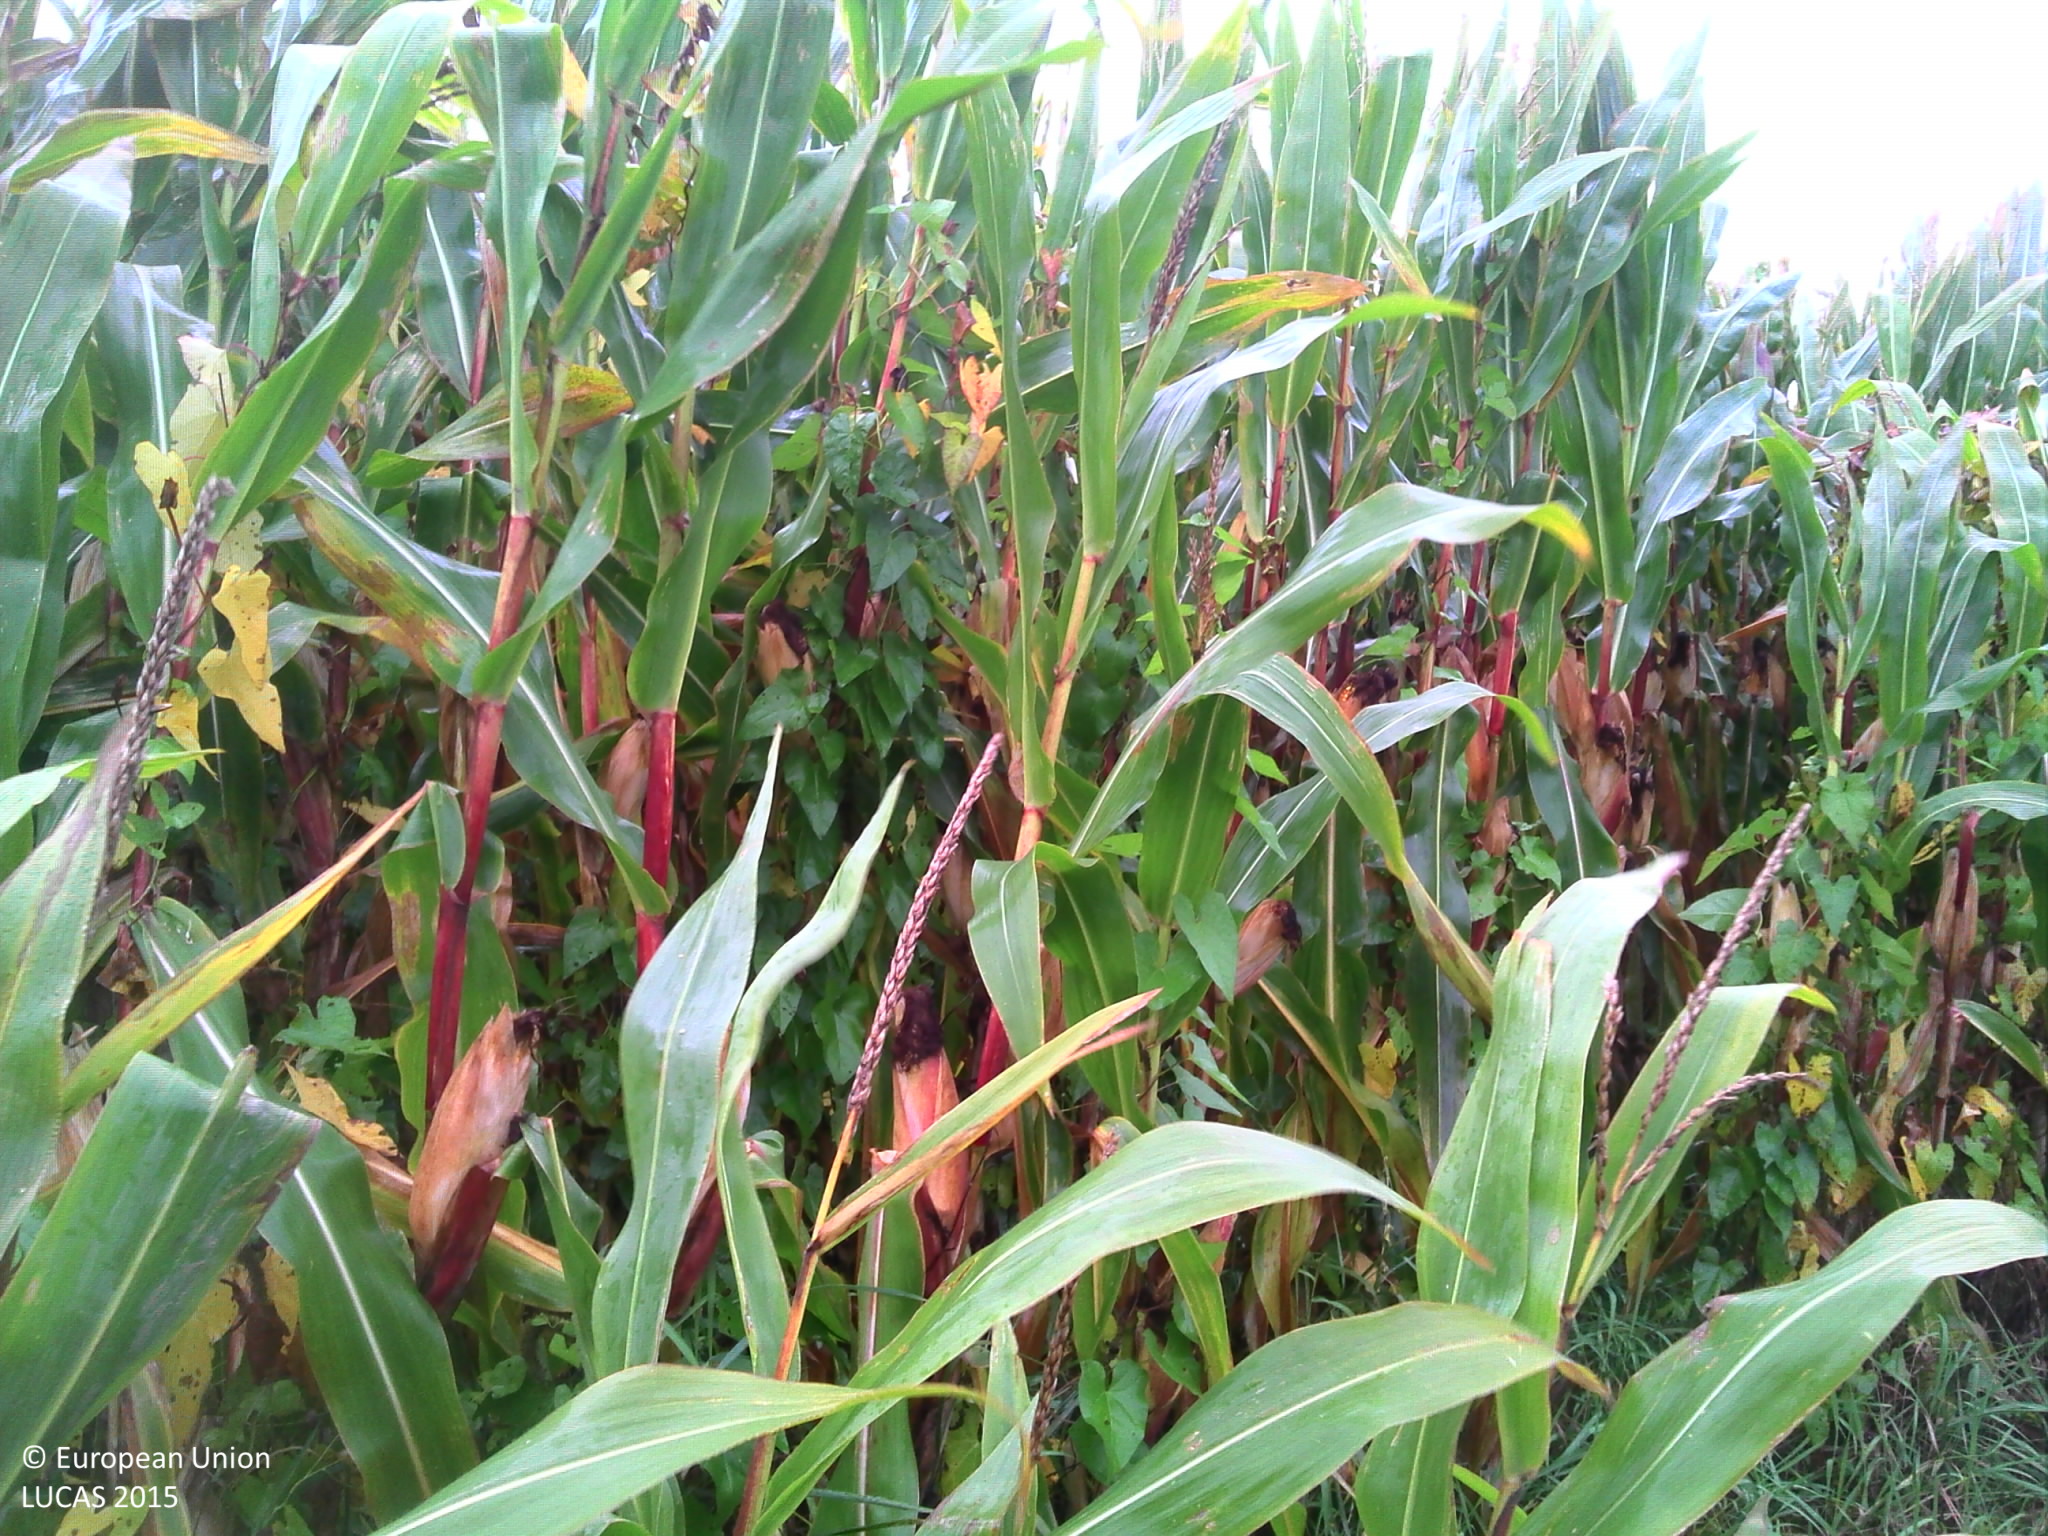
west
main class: Cropland
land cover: Maize
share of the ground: > 75 %
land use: Agriculture (excluding fallow land and kitchen gardens)
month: October
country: BE
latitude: 50.9242
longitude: 2.9761
